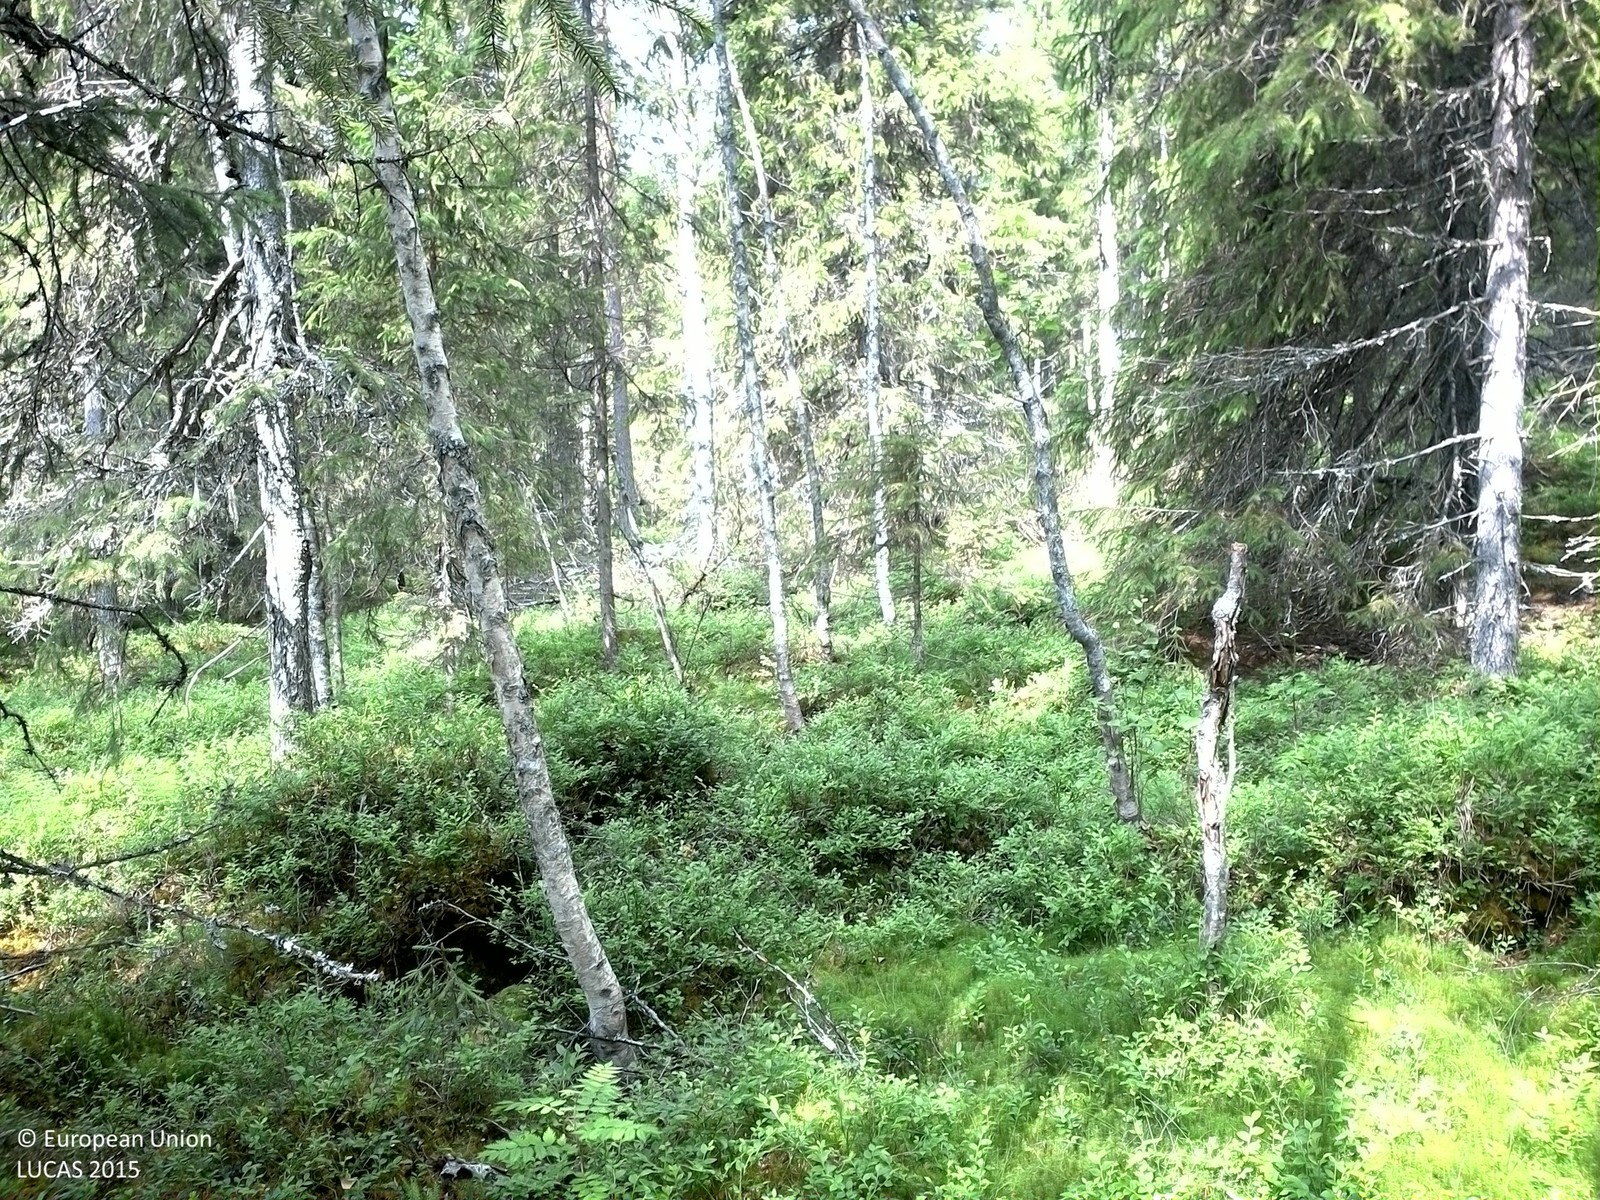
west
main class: Woodland
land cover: Spruce dominated mixed woodland
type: boreal forest
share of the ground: 50 - 75 %
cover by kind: coniferous forest trees 40 %, shrubs 25 %, broadleaved forest trees 15 %, lichens and mosses 15 %, herbaceous plants 5 %
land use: Forestry
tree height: > 5 m
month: July
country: SE
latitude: 63.4787
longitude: 17.4613
